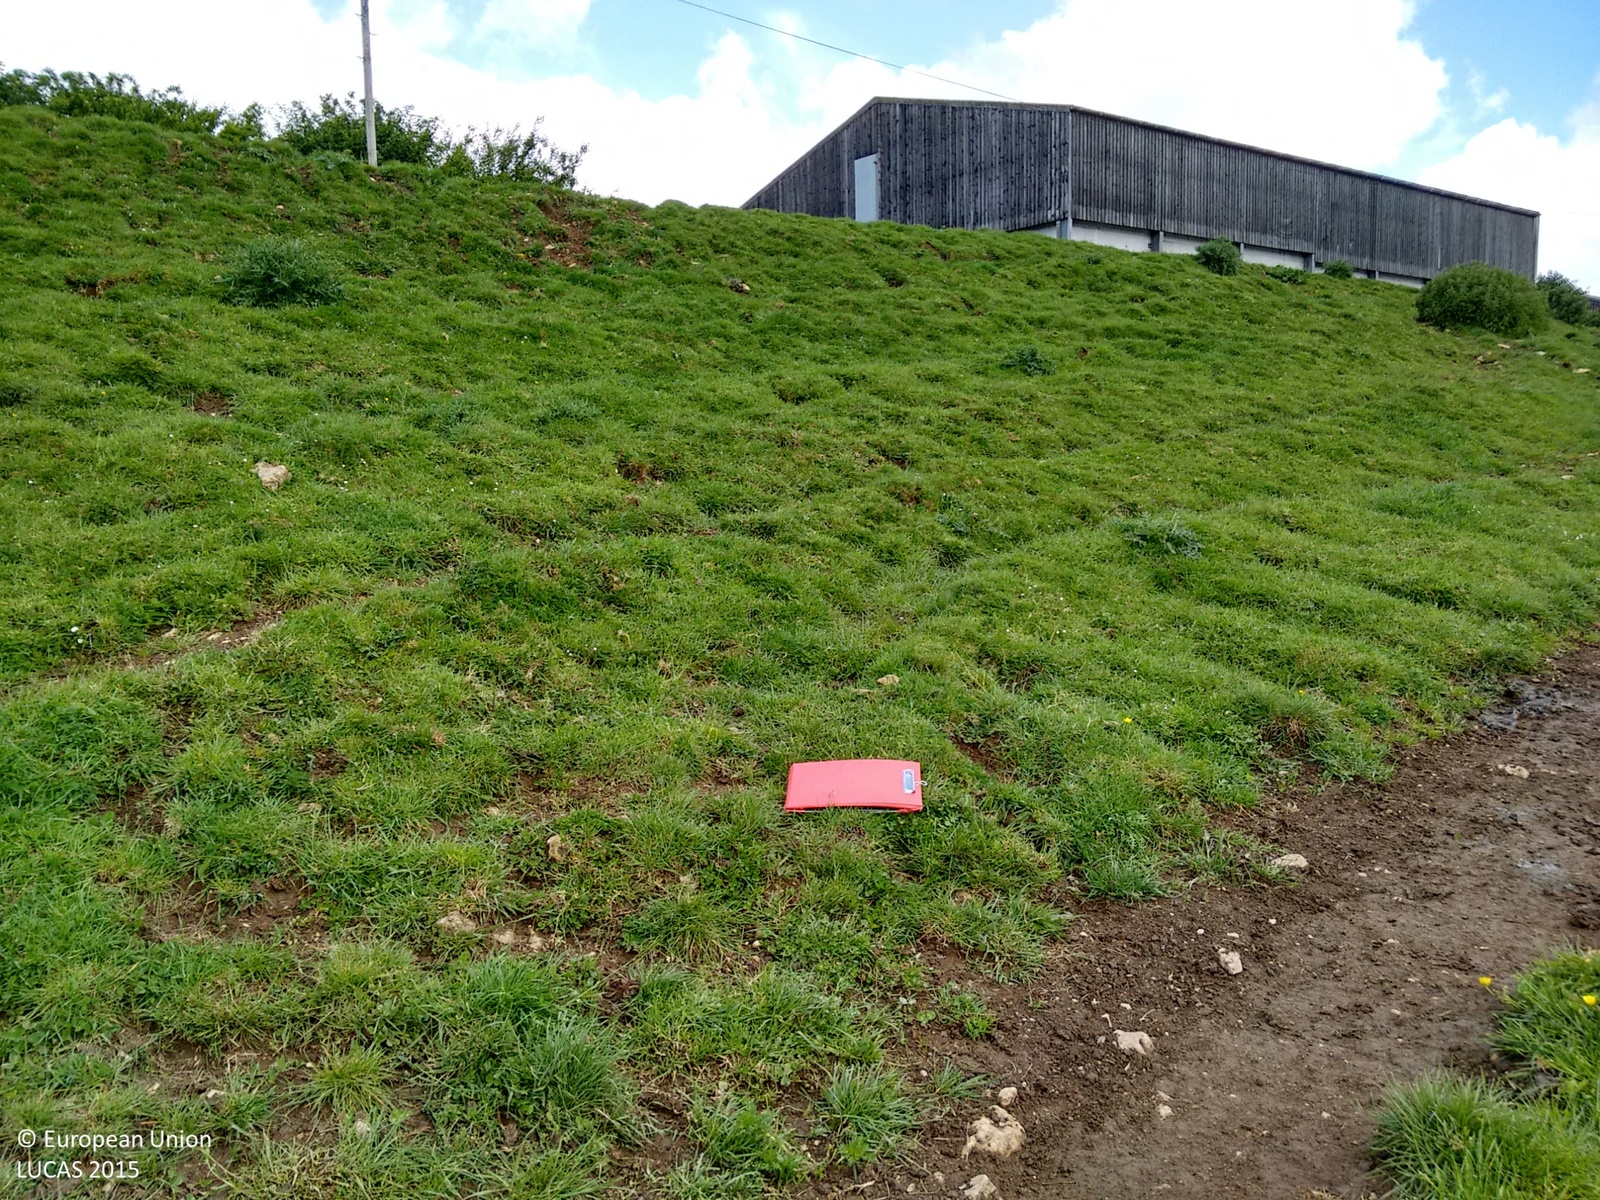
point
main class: Grassland
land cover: Grassland without tree/shrub cover
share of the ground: > 75 %
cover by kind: herbaceous plants 100 %
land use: Agriculture (excluding fallow land and kitchen gardens)
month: May
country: GB
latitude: 50.9529
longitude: -2.4646
